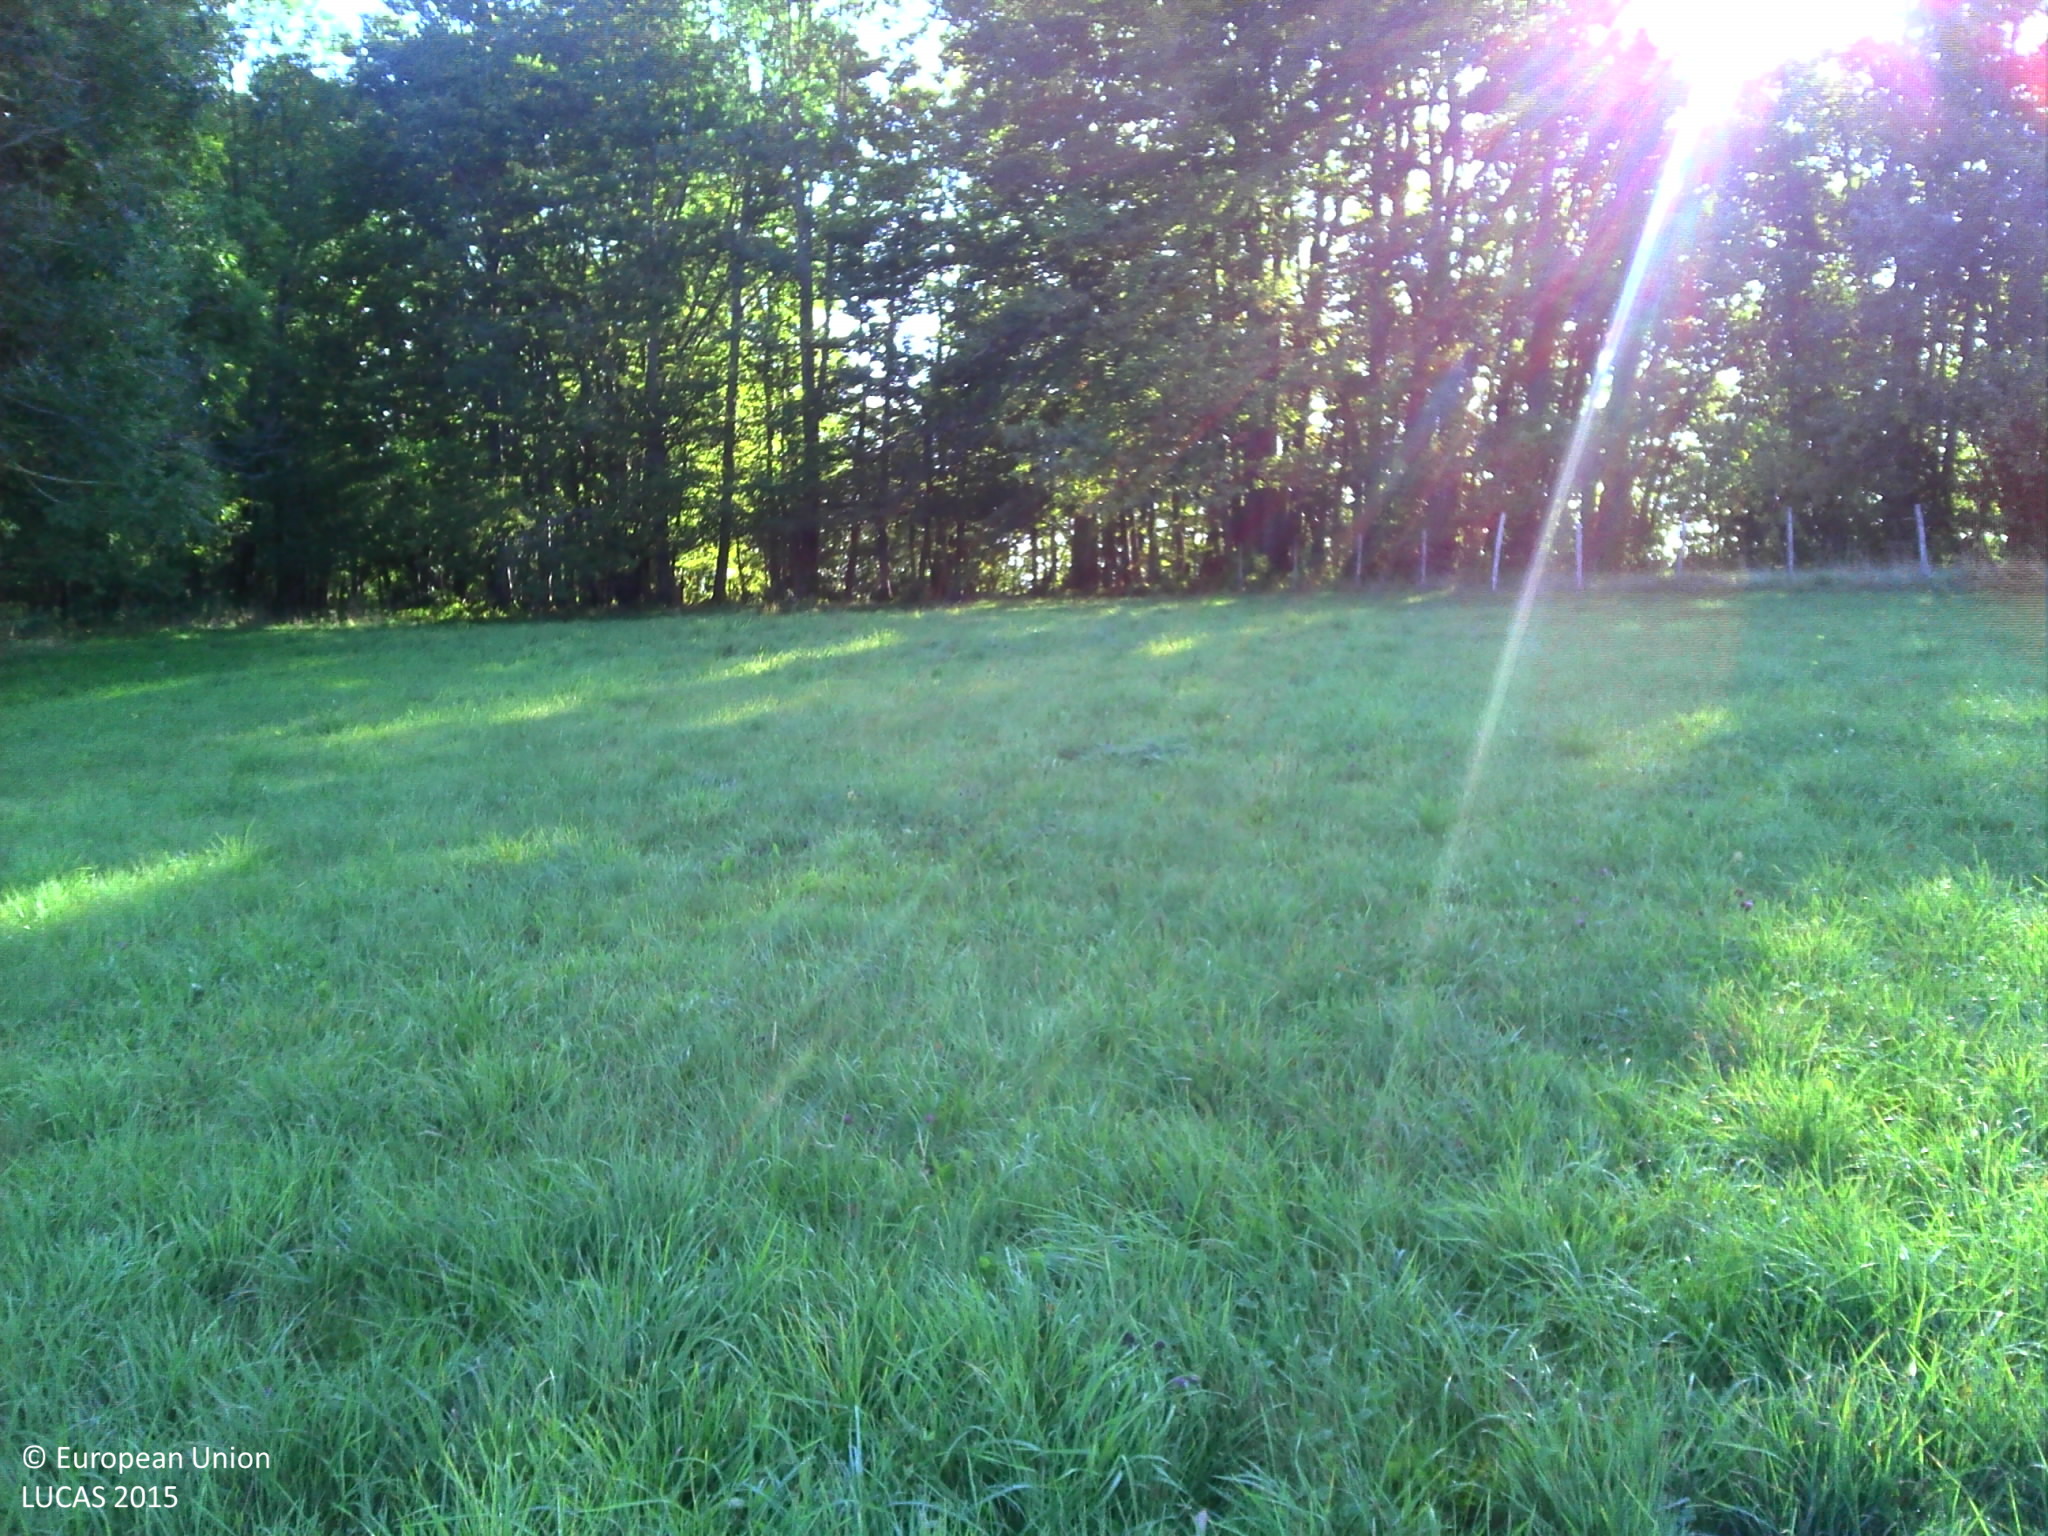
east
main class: Grassland
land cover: Grassland without tree/shrub cover
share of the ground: > 75 %
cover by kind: herbaceous plants 100 %
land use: Agriculture (excluding fallow land and kitchen gardens)
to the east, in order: Grassland without tree/shrub cover; Fences; Broadleaved woodland; Fences; Spruce dominated coniferous woodland; Tracks; Fences; Grassland without tree/shrub cover
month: September
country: FR
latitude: 47.2800
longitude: 6.9217
